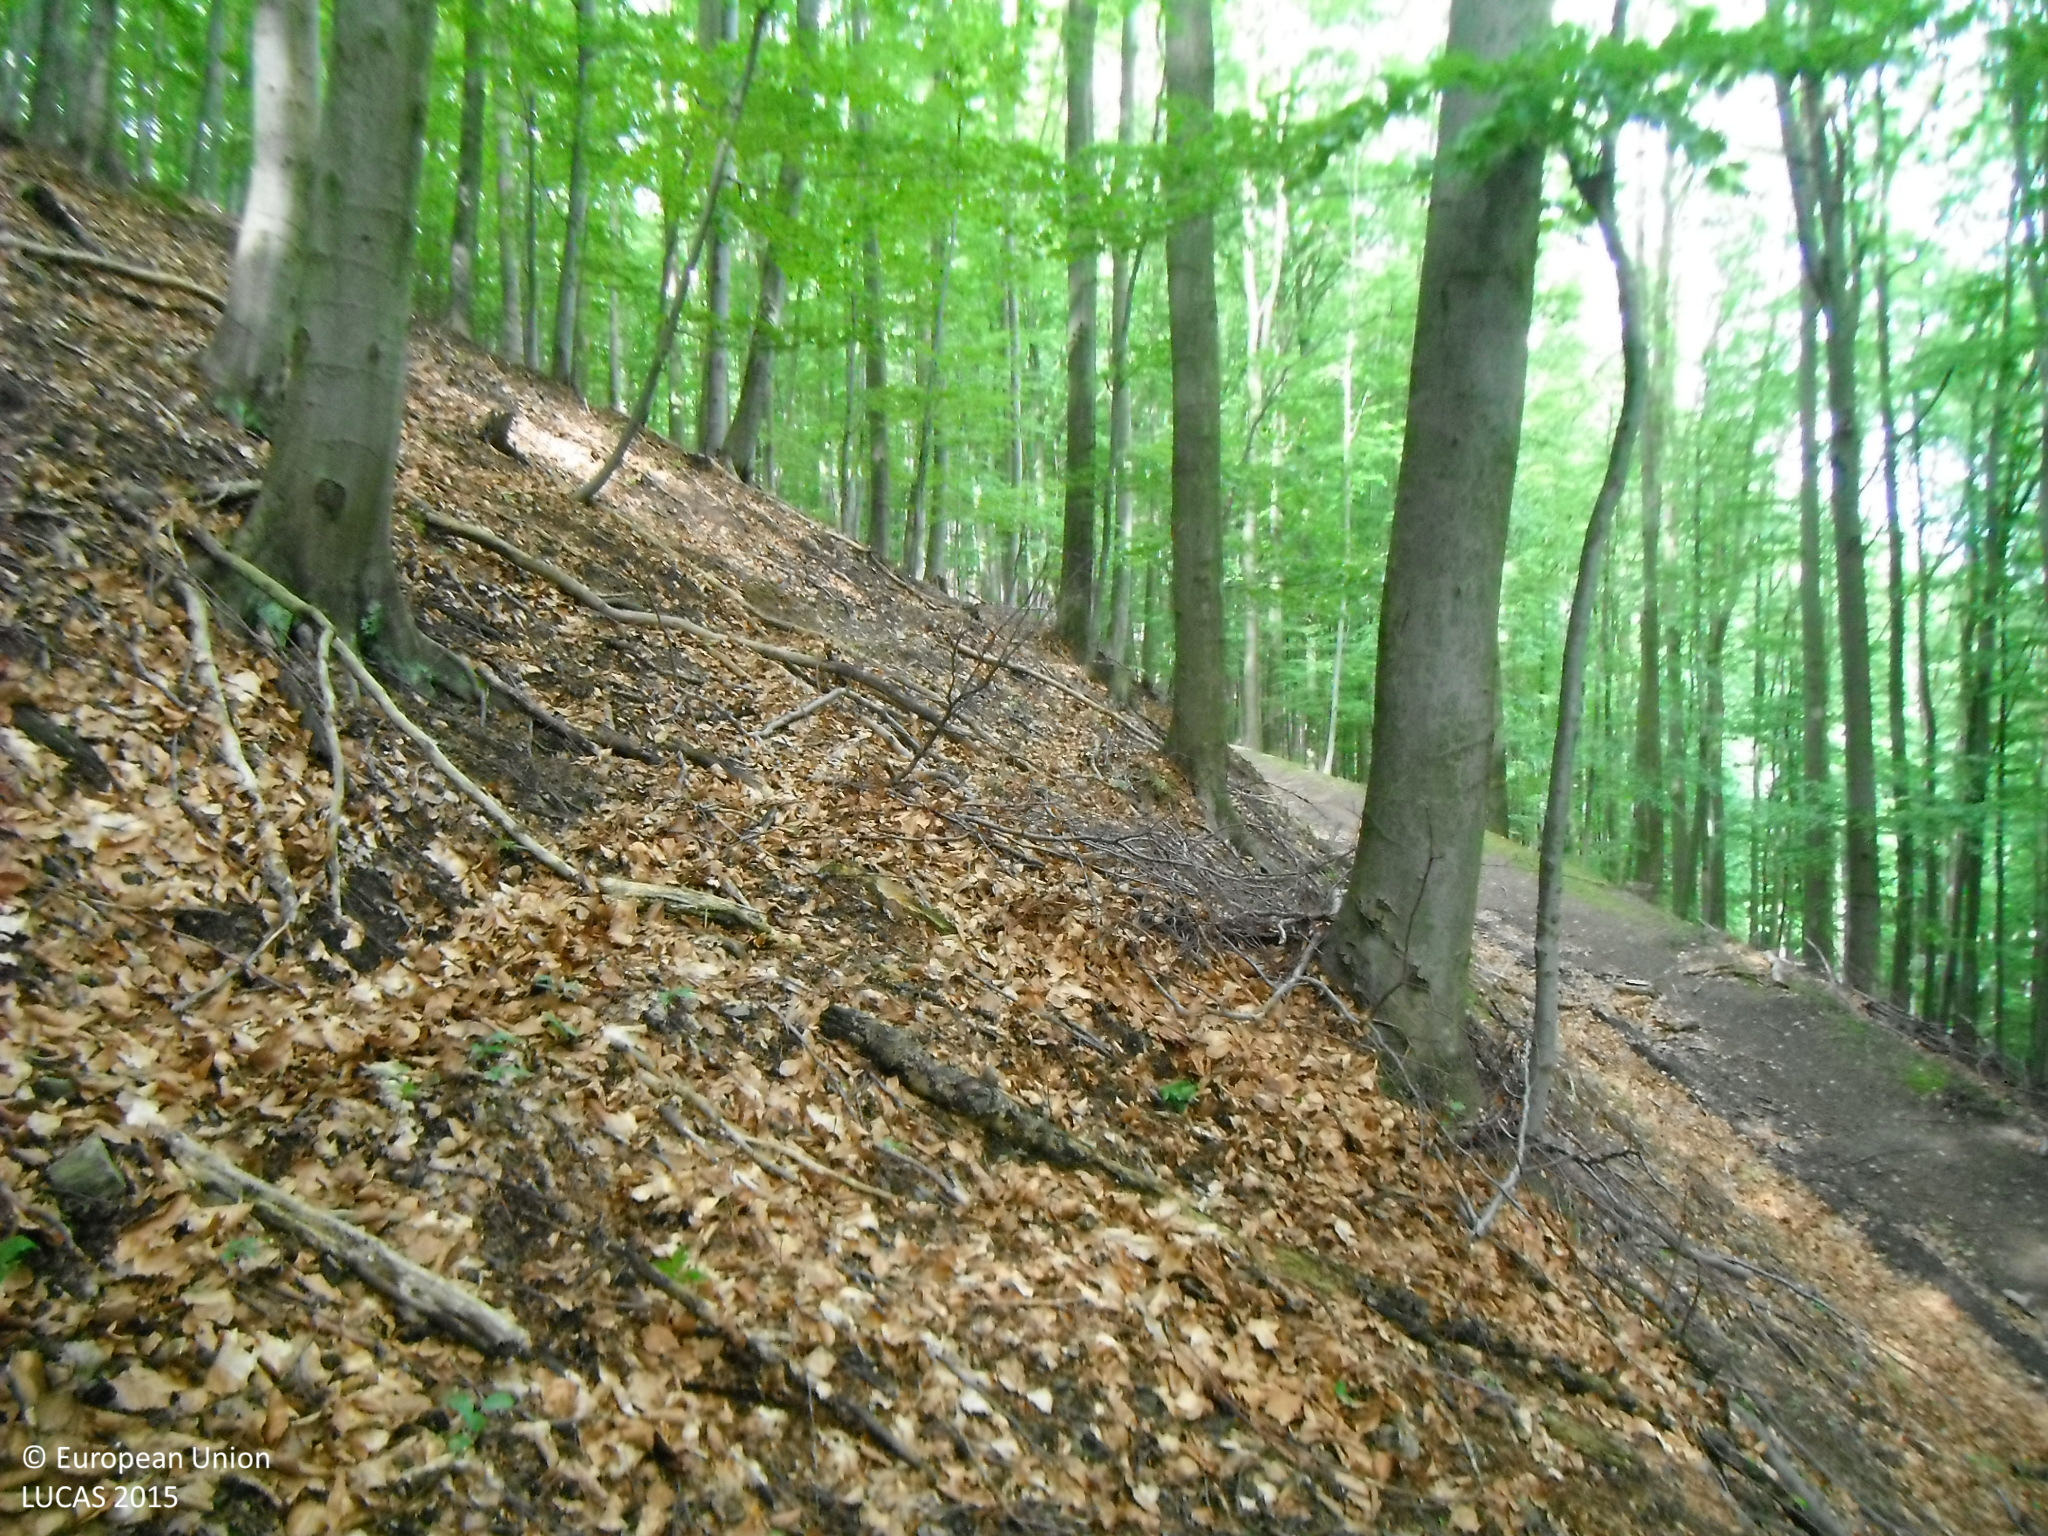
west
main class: Woodland
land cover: Broadleaved woodland
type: mountainous beech forest
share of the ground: > 75 %
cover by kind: broadleaved forest trees 100 %
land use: Forestry
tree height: > 5 m
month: May
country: SK
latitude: 48.4029
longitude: 17.2087
